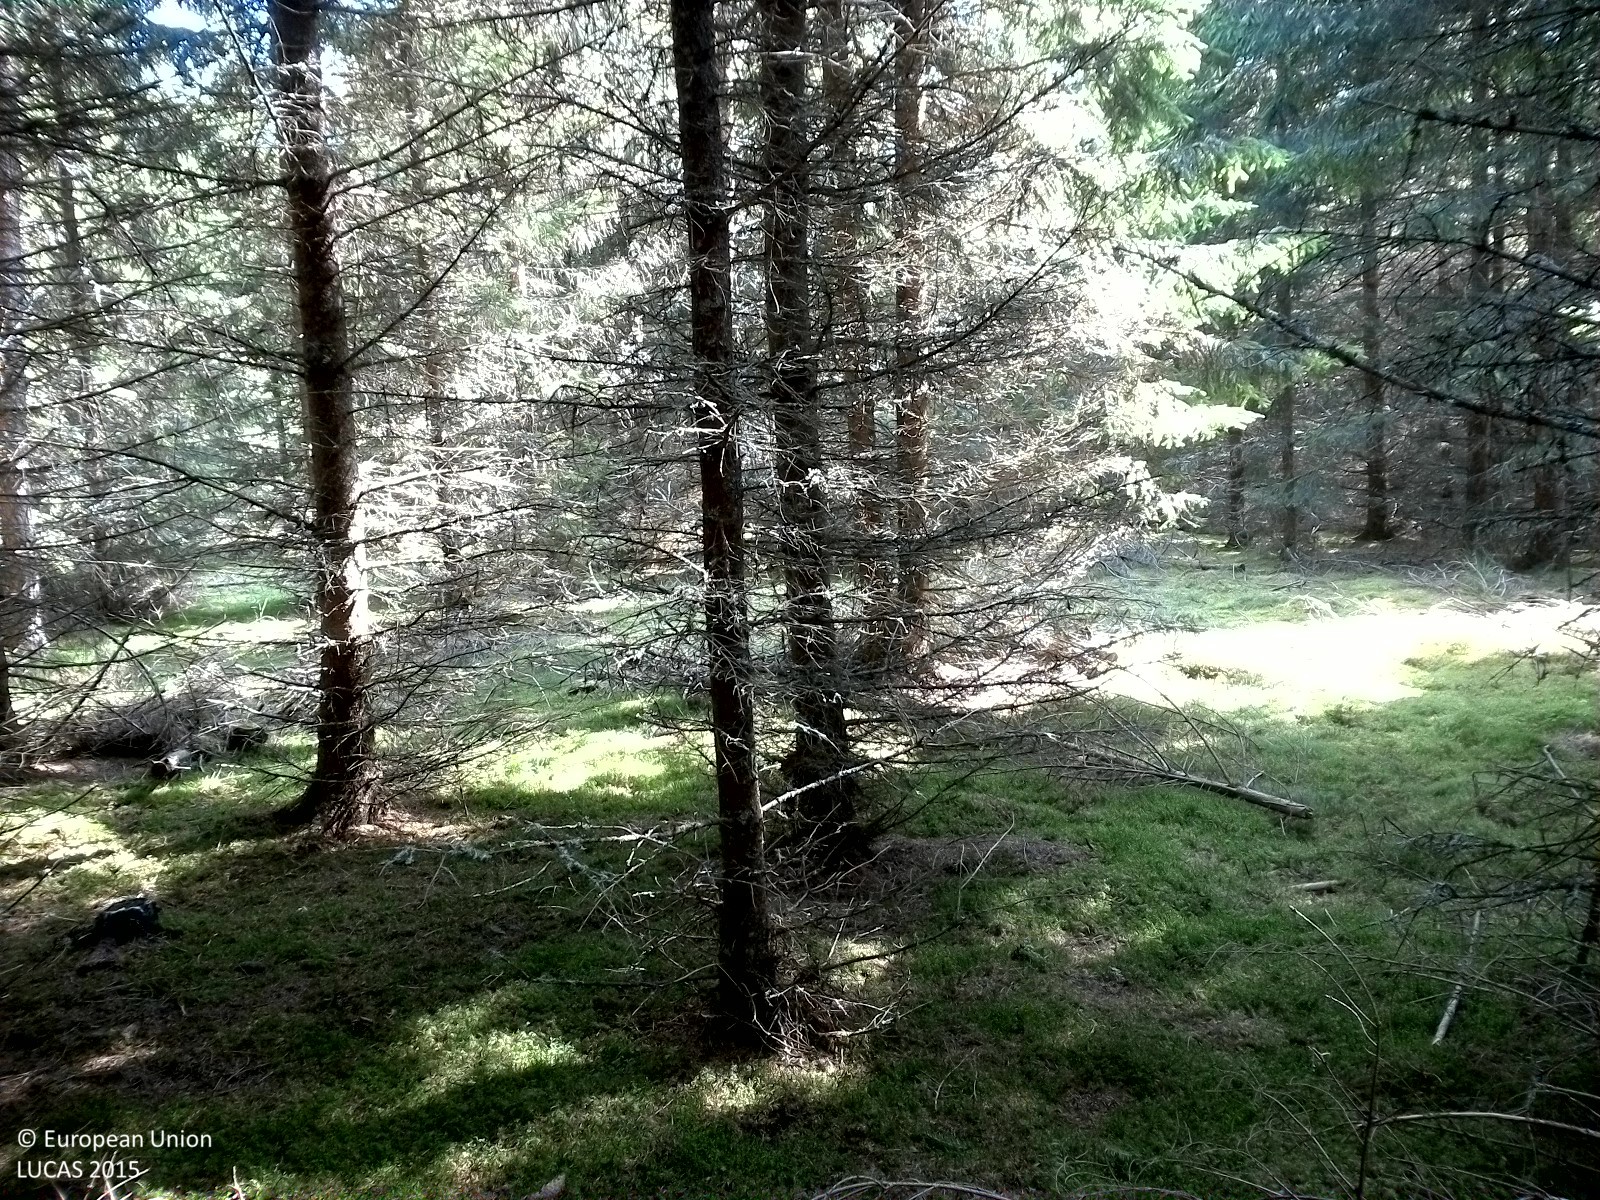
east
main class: Woodland
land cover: Spruce dominated coniferous woodland
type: boreal forest
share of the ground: 50 - 75 %
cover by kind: coniferous forest trees 70 %, lichens and mosses 30 %
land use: Forestry
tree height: > 5 m
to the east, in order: Spruce dominated coniferous woodland; Spruce dominated mixed woodland; Rivers and streams; Spruce dominated mixed woodland; Pine dominated mixed woodland
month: August
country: SE
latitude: 58.7387
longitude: 15.0206
